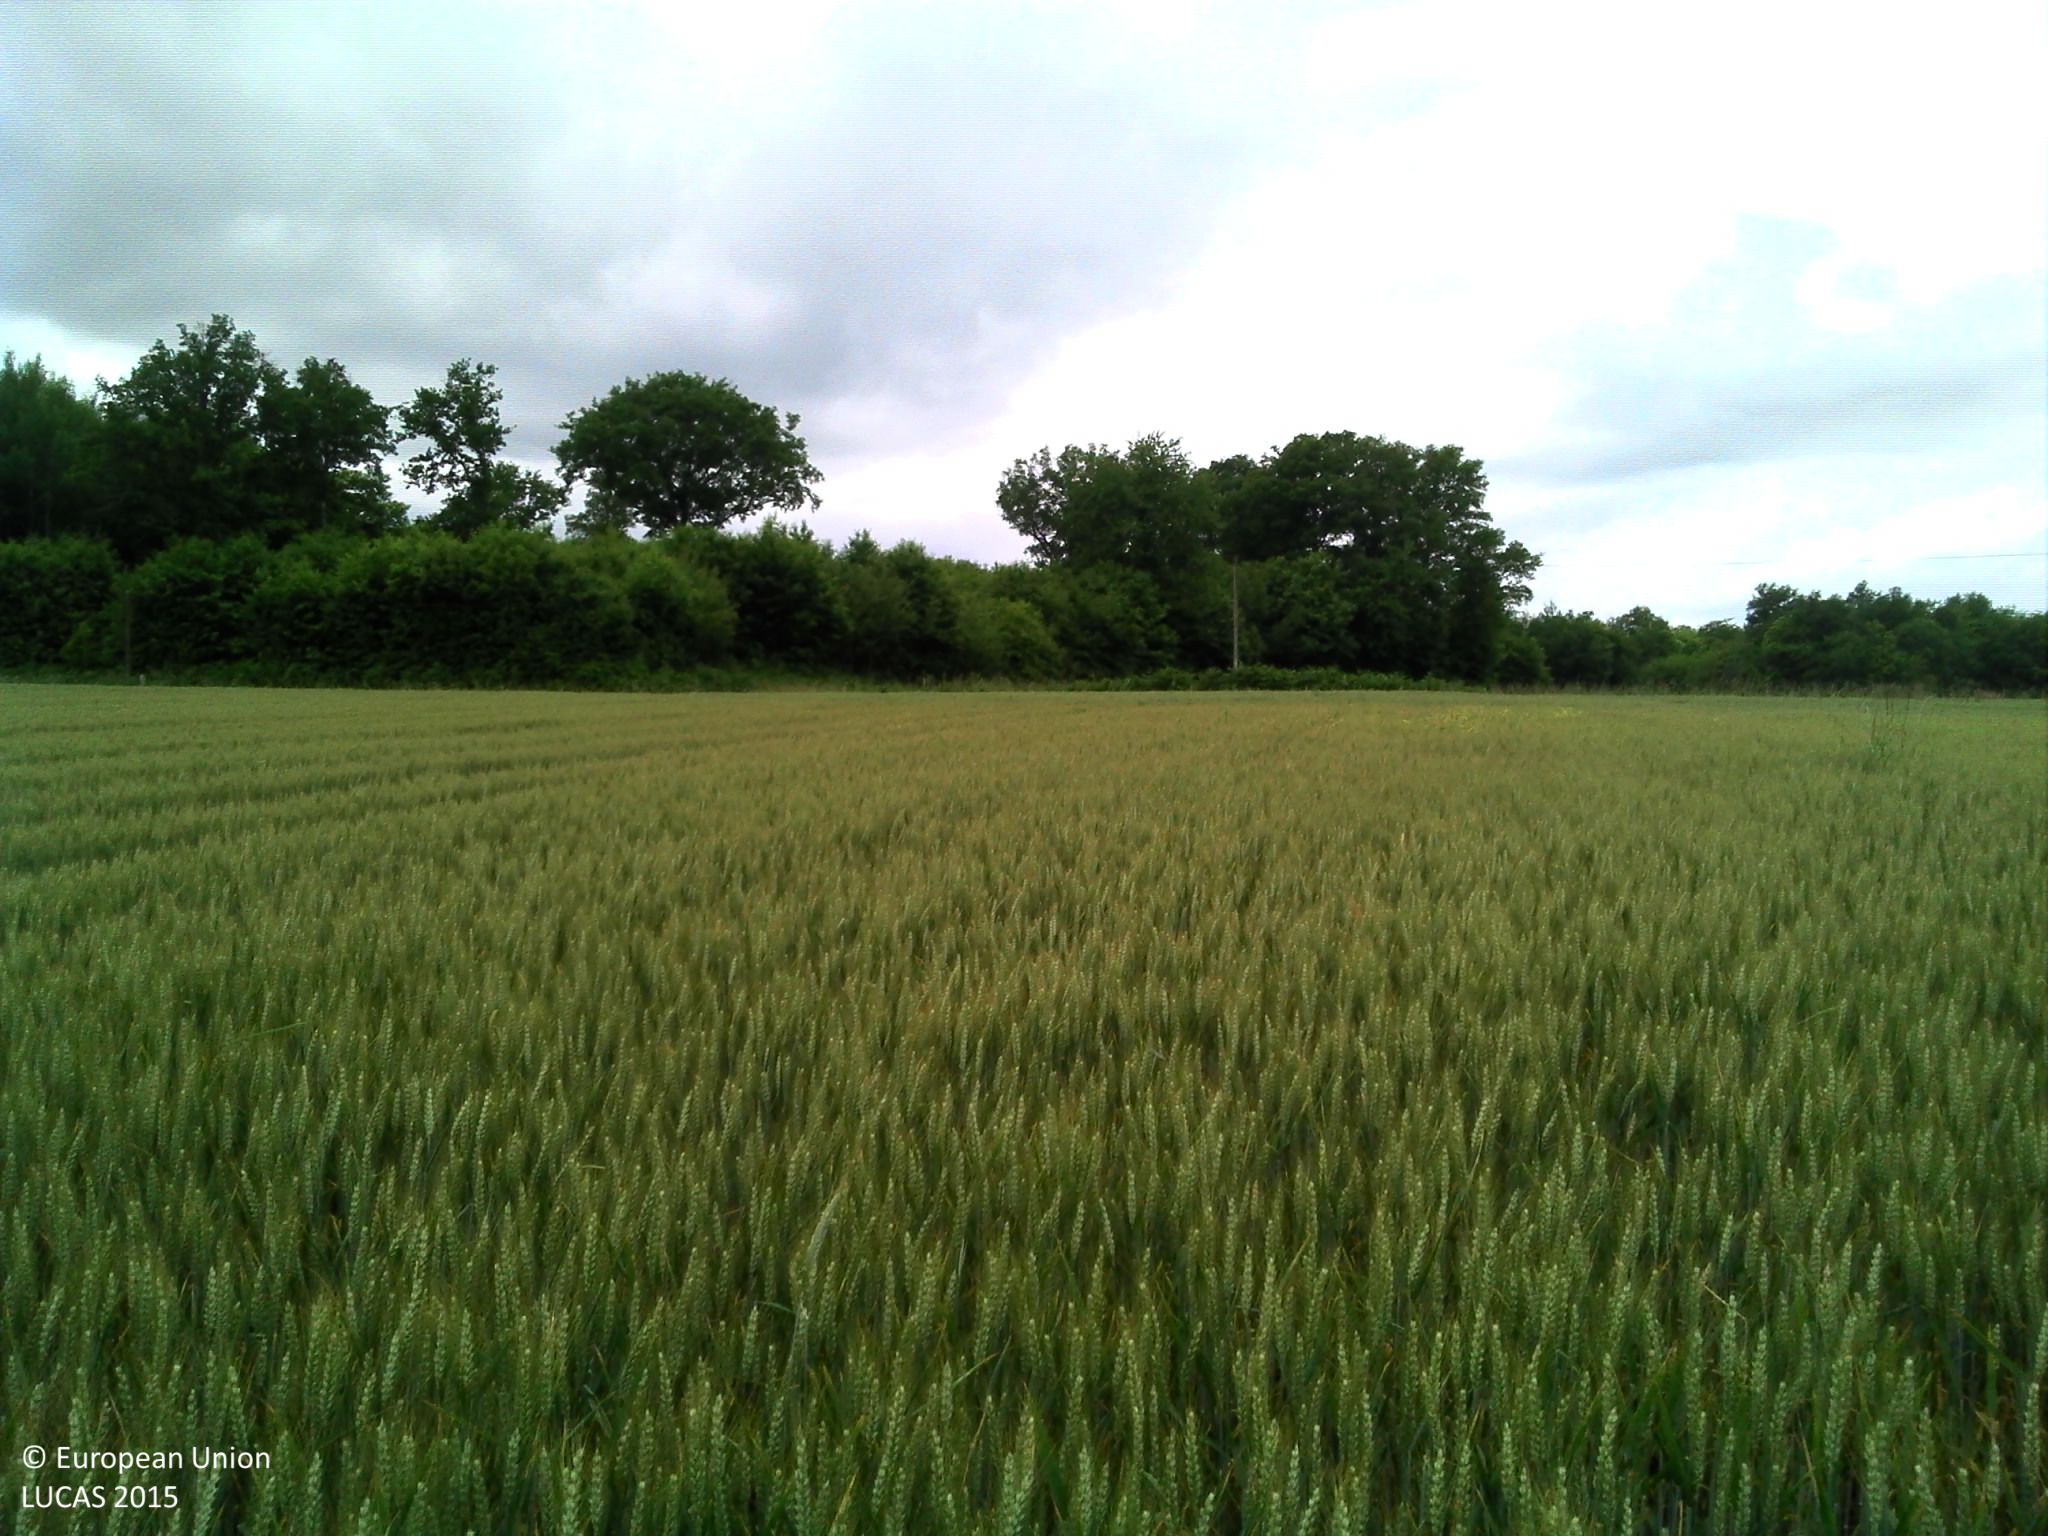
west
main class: Cropland
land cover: Common wheat
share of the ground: > 75 %
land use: Agriculture (excluding fallow land and kitchen gardens)
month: June
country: FR
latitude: 46.0260
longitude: 0.3853
